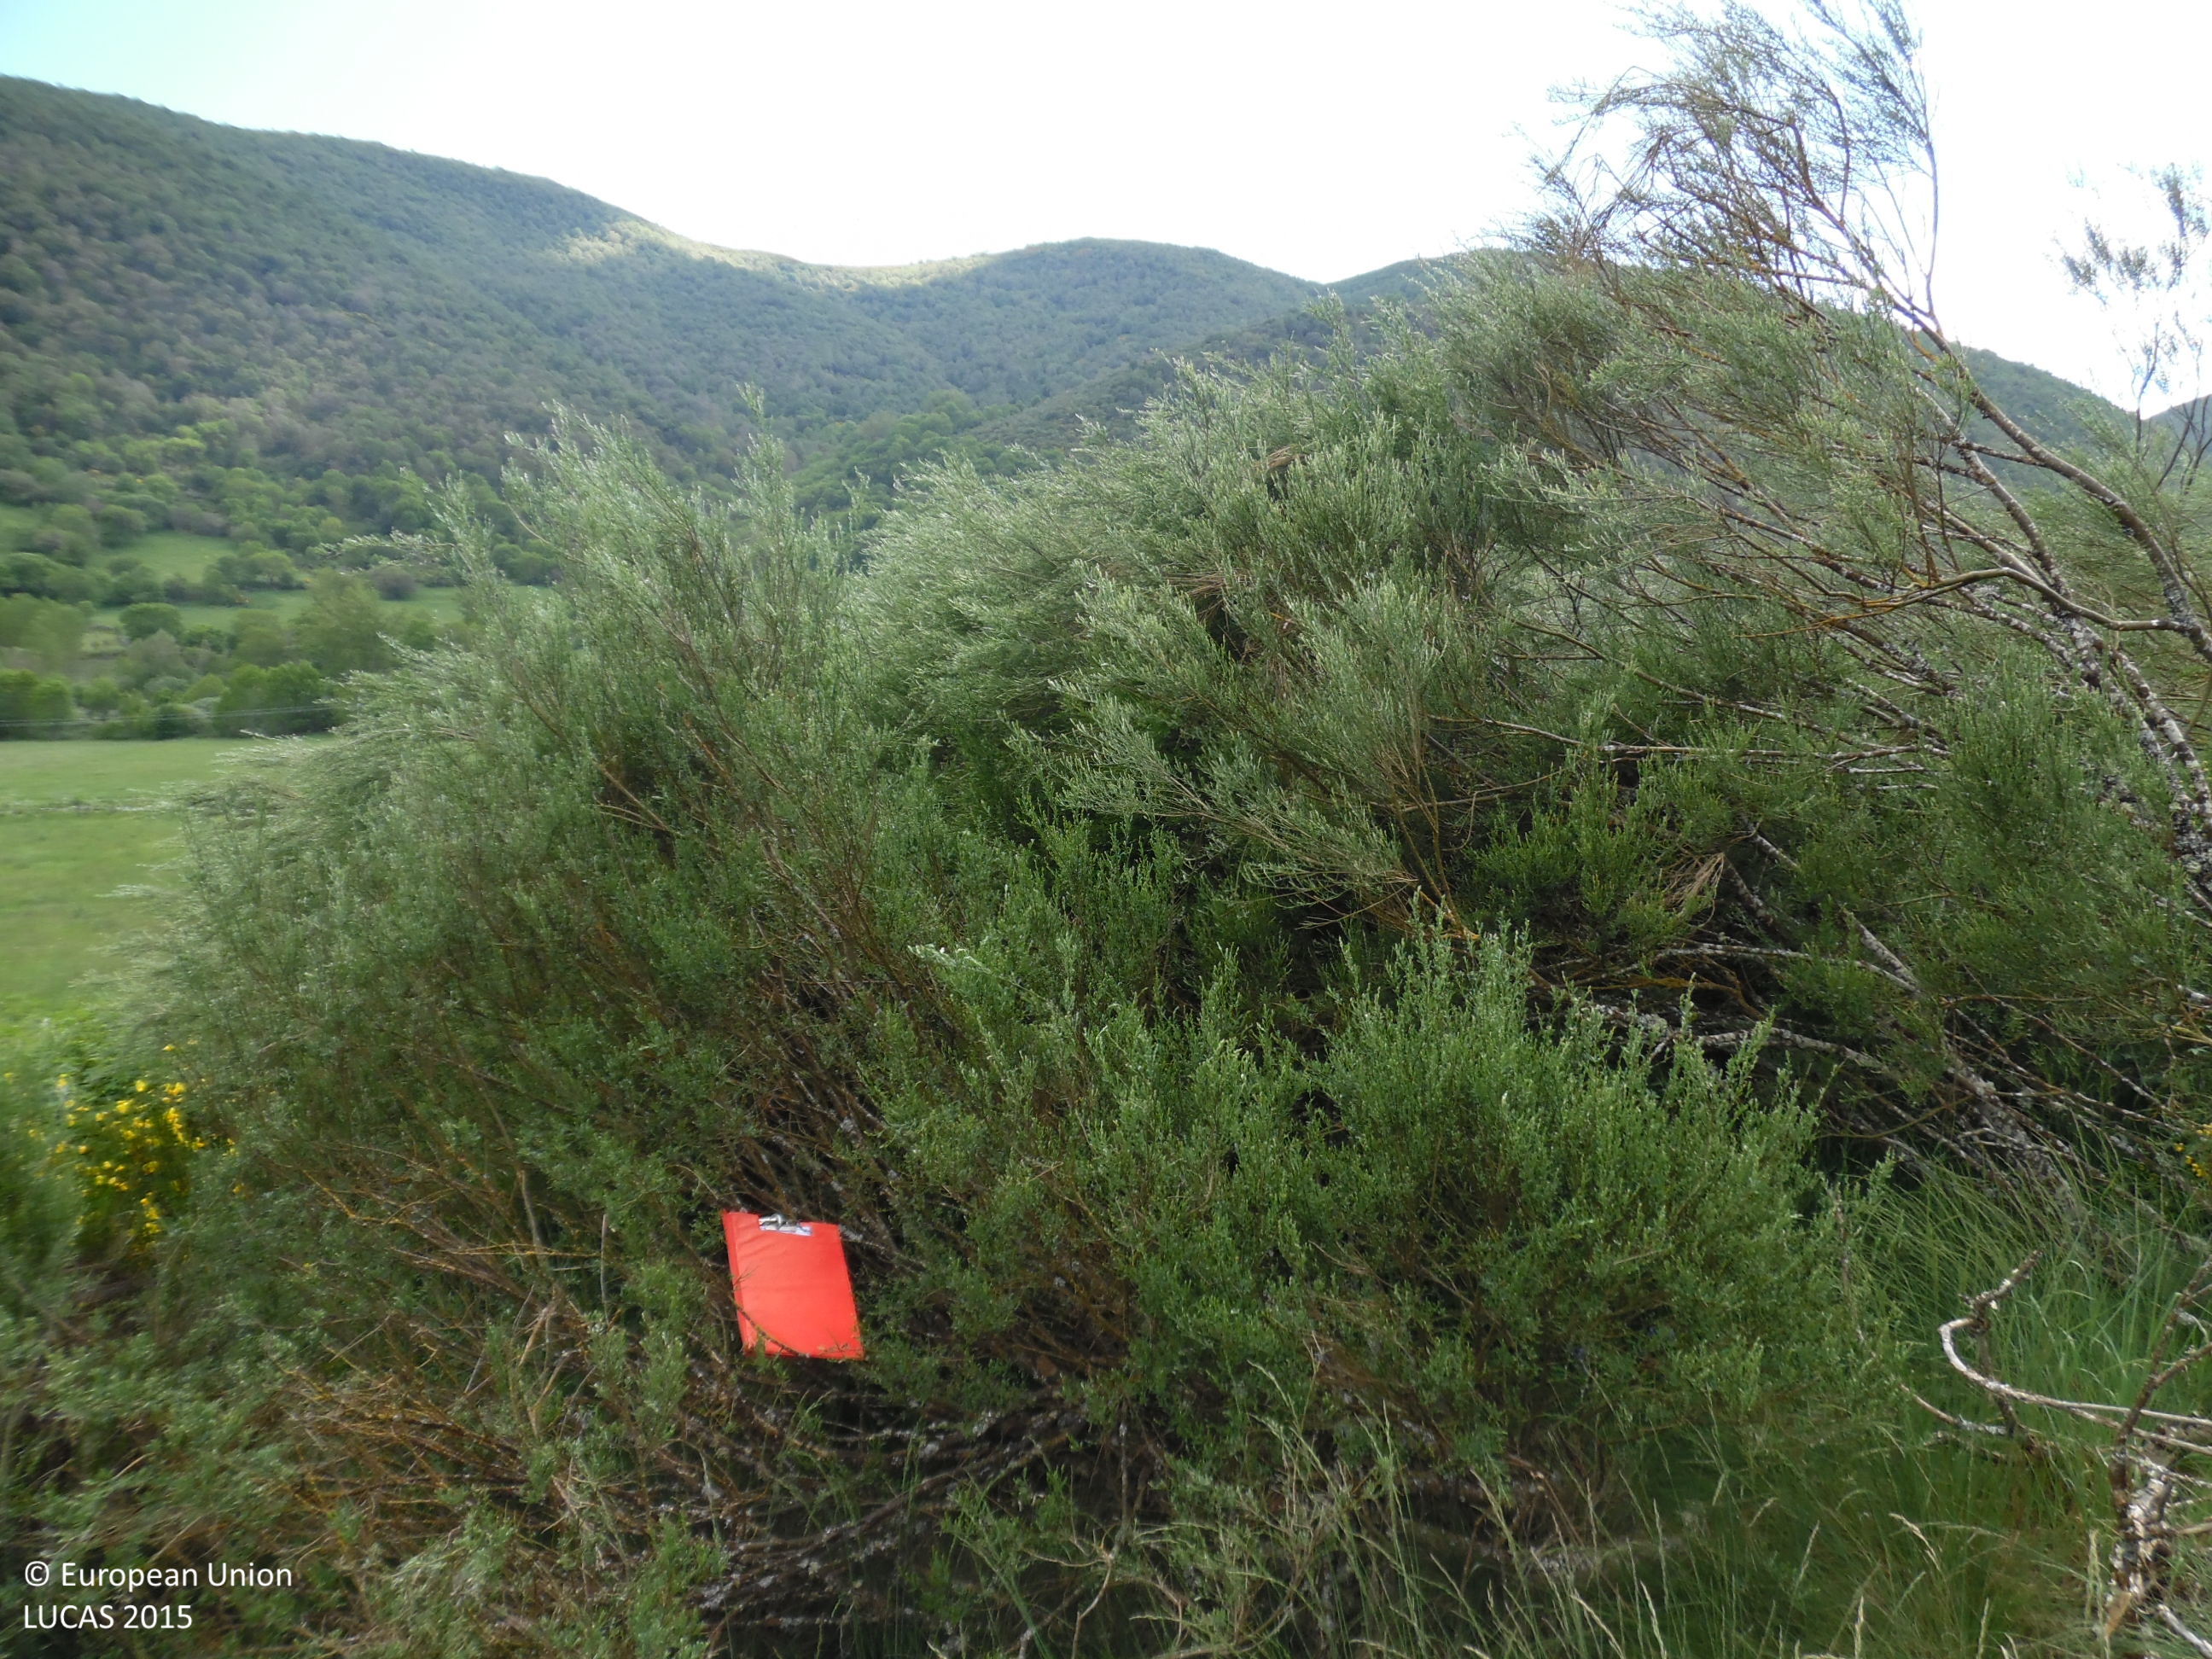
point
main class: Shrubland
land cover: Shrubland with sparse tree cover
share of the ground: 50 - 75 %
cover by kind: shrubs 85 %, herbaceous plants 10 %, coniferous forest trees 5 %
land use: Abandoned areas
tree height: < 5 m
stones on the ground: 10 - 25 %
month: May
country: ES
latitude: 42.8500
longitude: -6.1809
